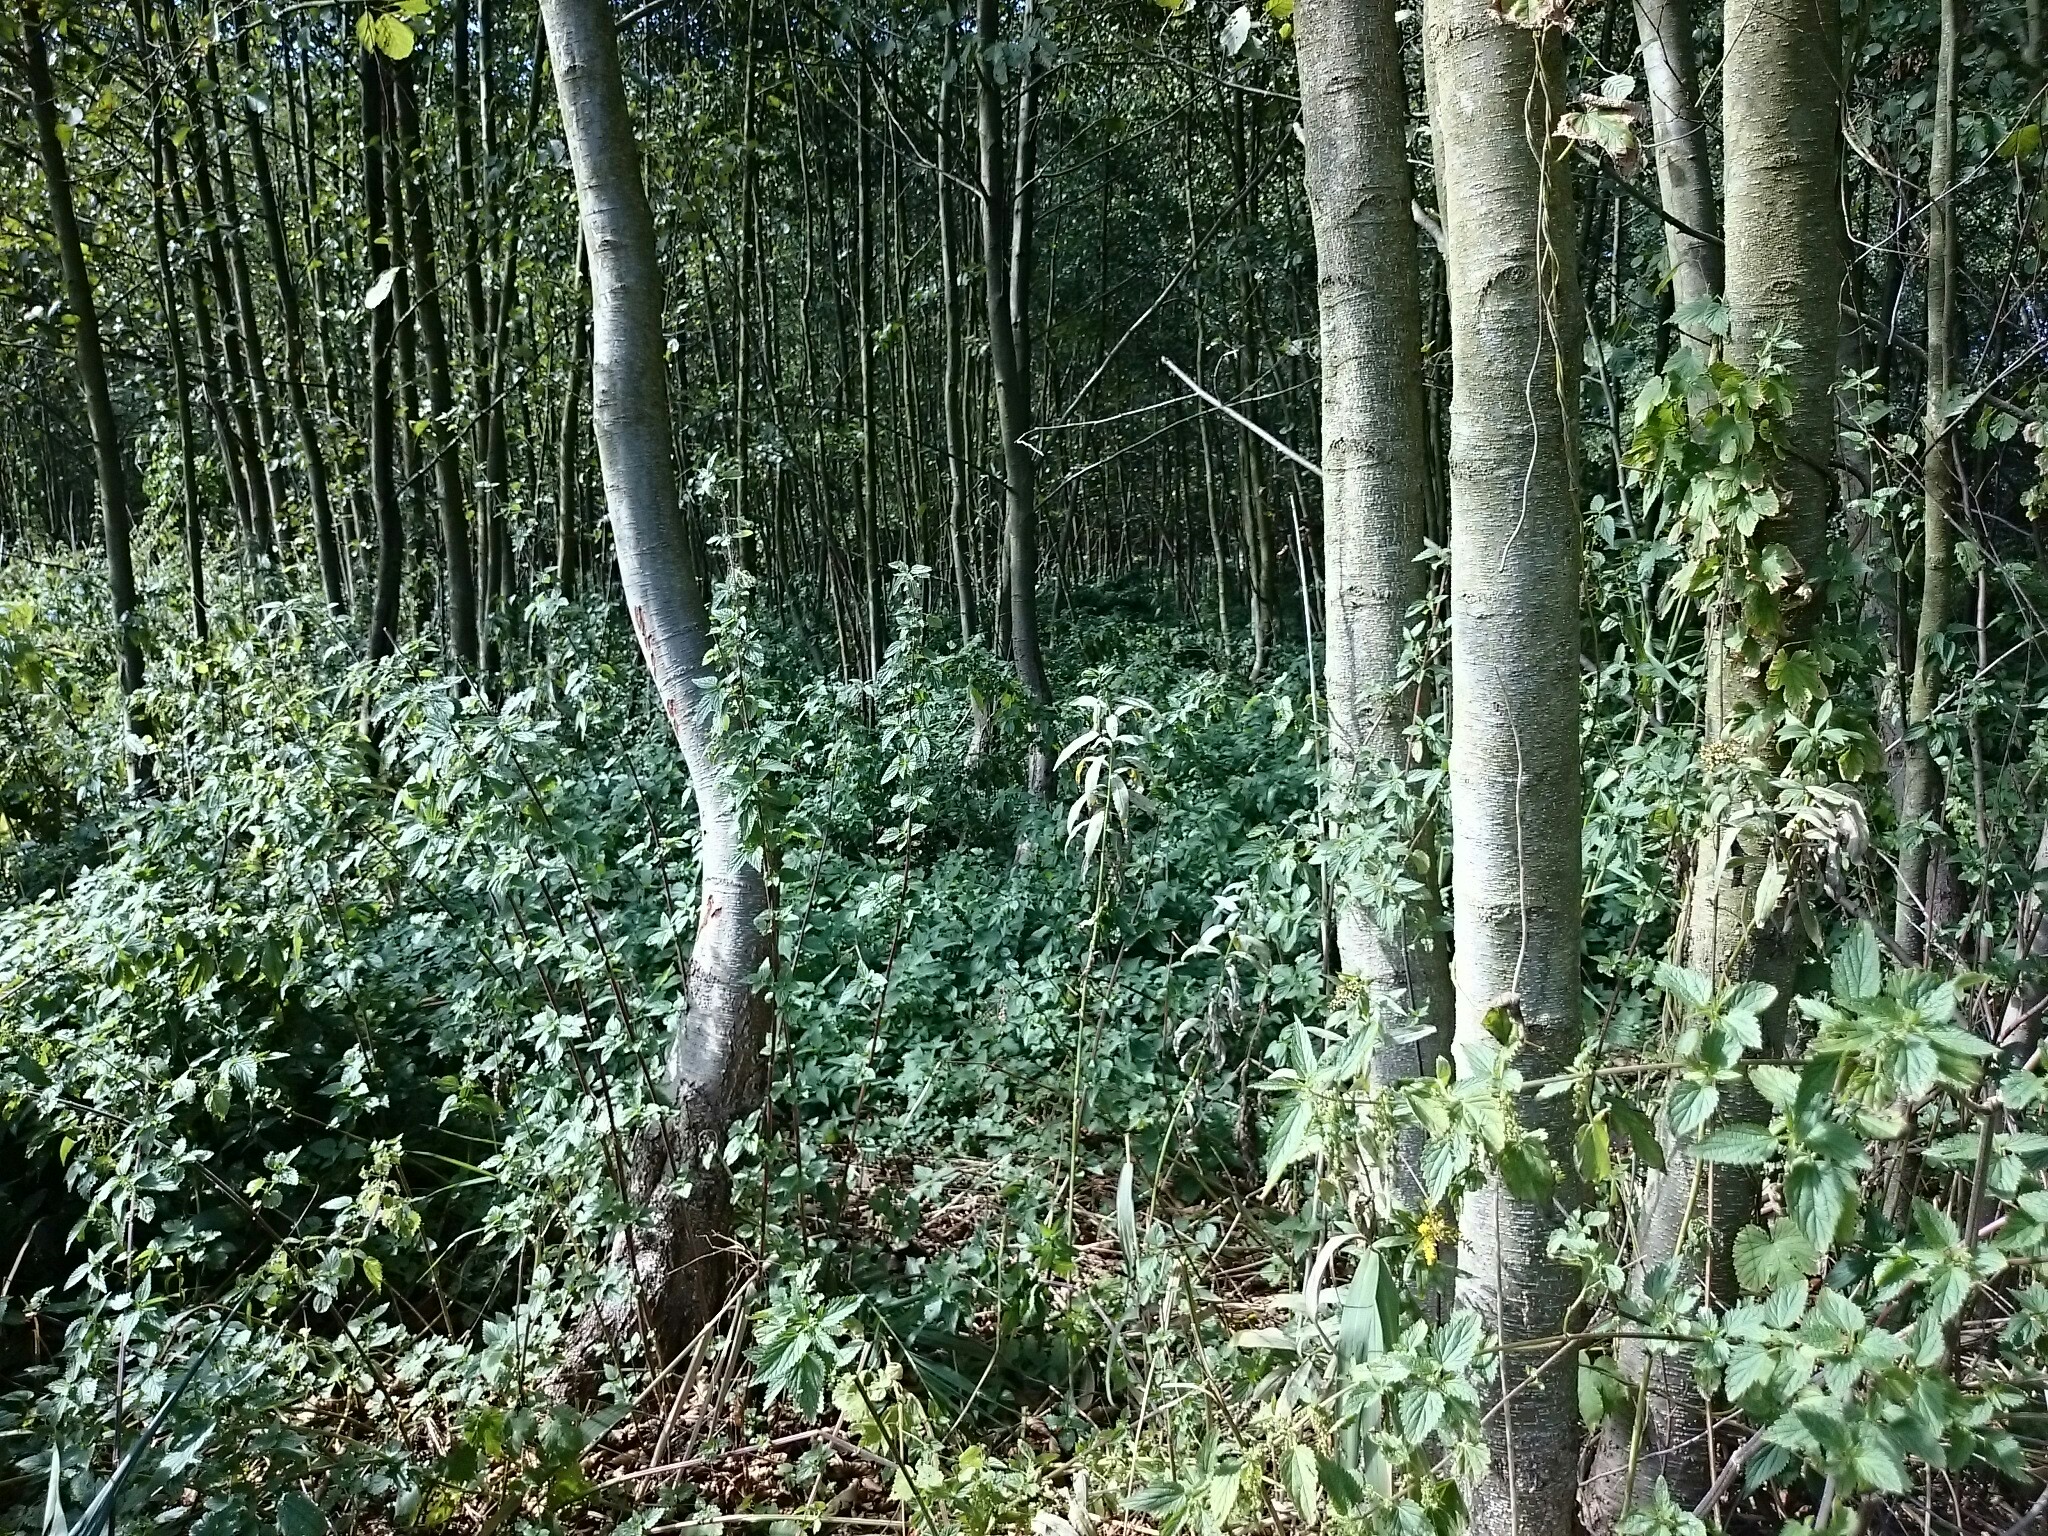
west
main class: Woodland
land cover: Broadleaved woodland
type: mesophytic deciduous forest
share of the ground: > 75 %
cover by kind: broadleaved forest trees 80 %, herbaceous plants 20 %
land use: Forestry
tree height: > 5 m
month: September
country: PL
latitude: 51.1783
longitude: 17.2928
